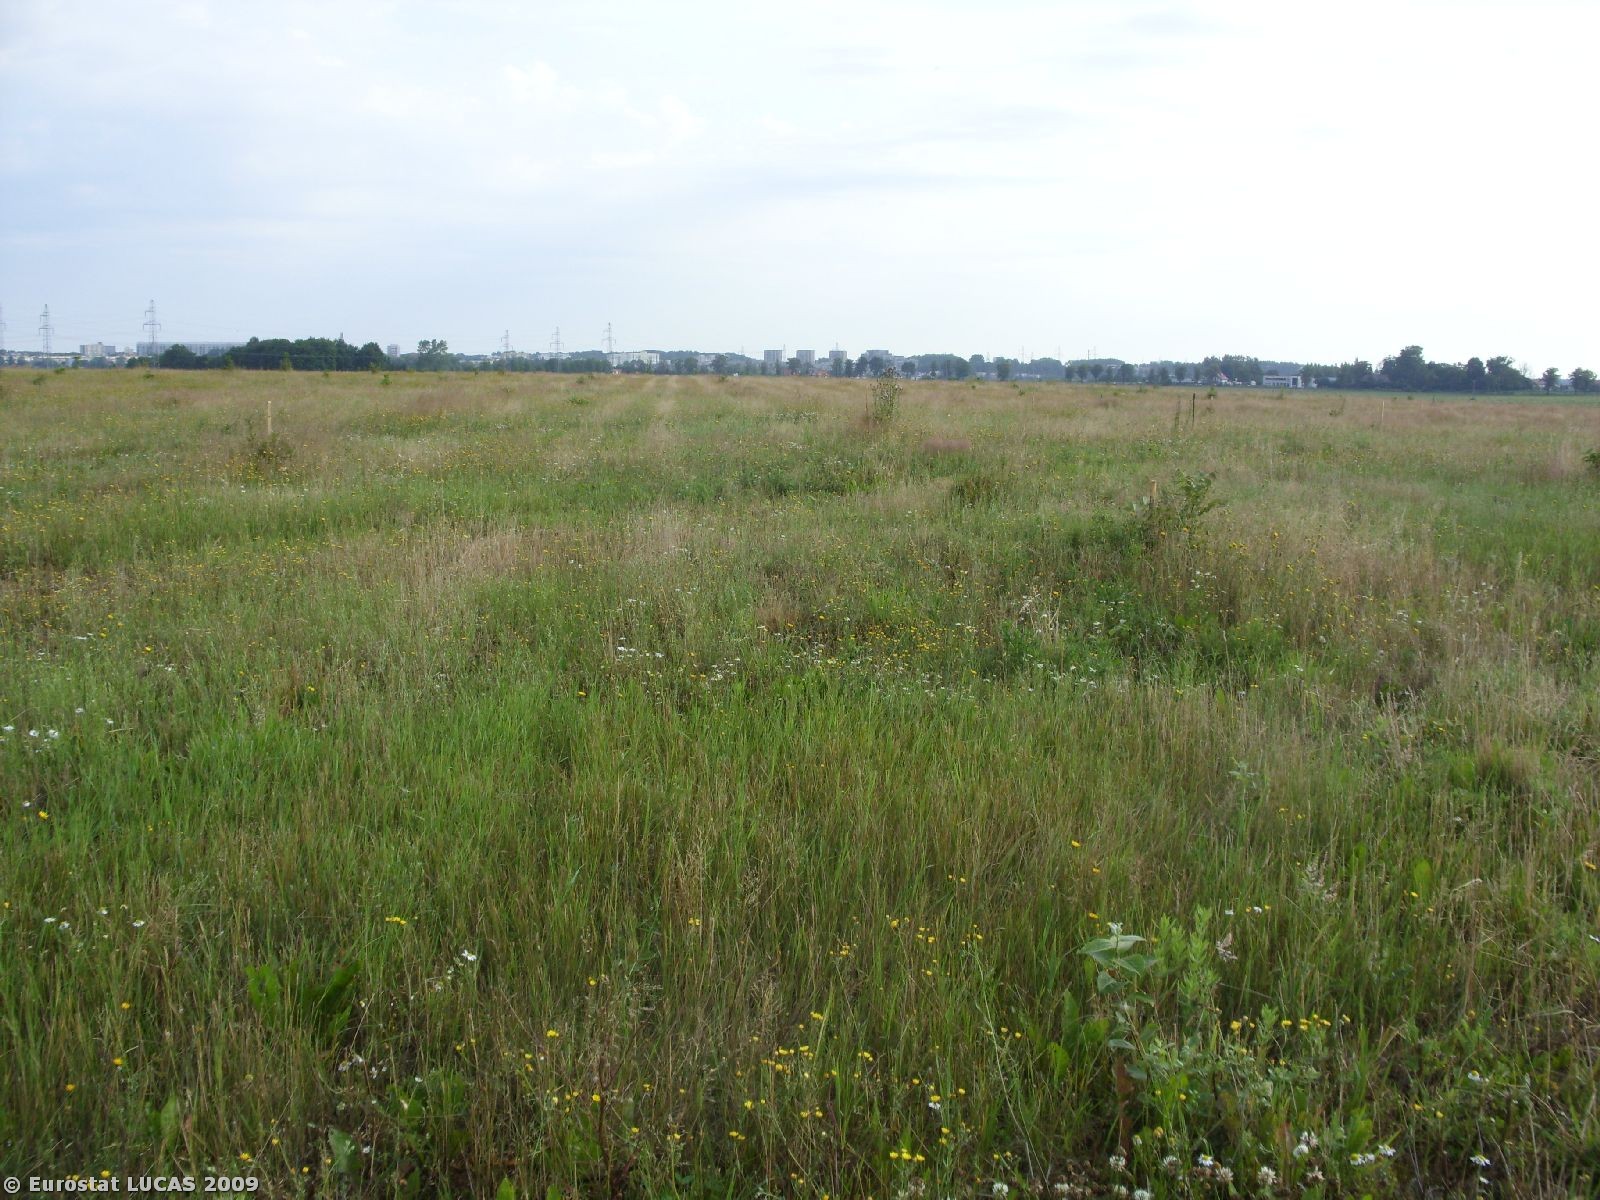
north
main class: Cropland
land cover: Nuts trees
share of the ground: < 10 %
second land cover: Grassland with sparse tree/shrub cover
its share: > 75 %
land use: Agriculture (excluding fallow land and kitchen gardens)
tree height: > 5 m
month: July
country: PL
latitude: 54.1557
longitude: 15.5922
